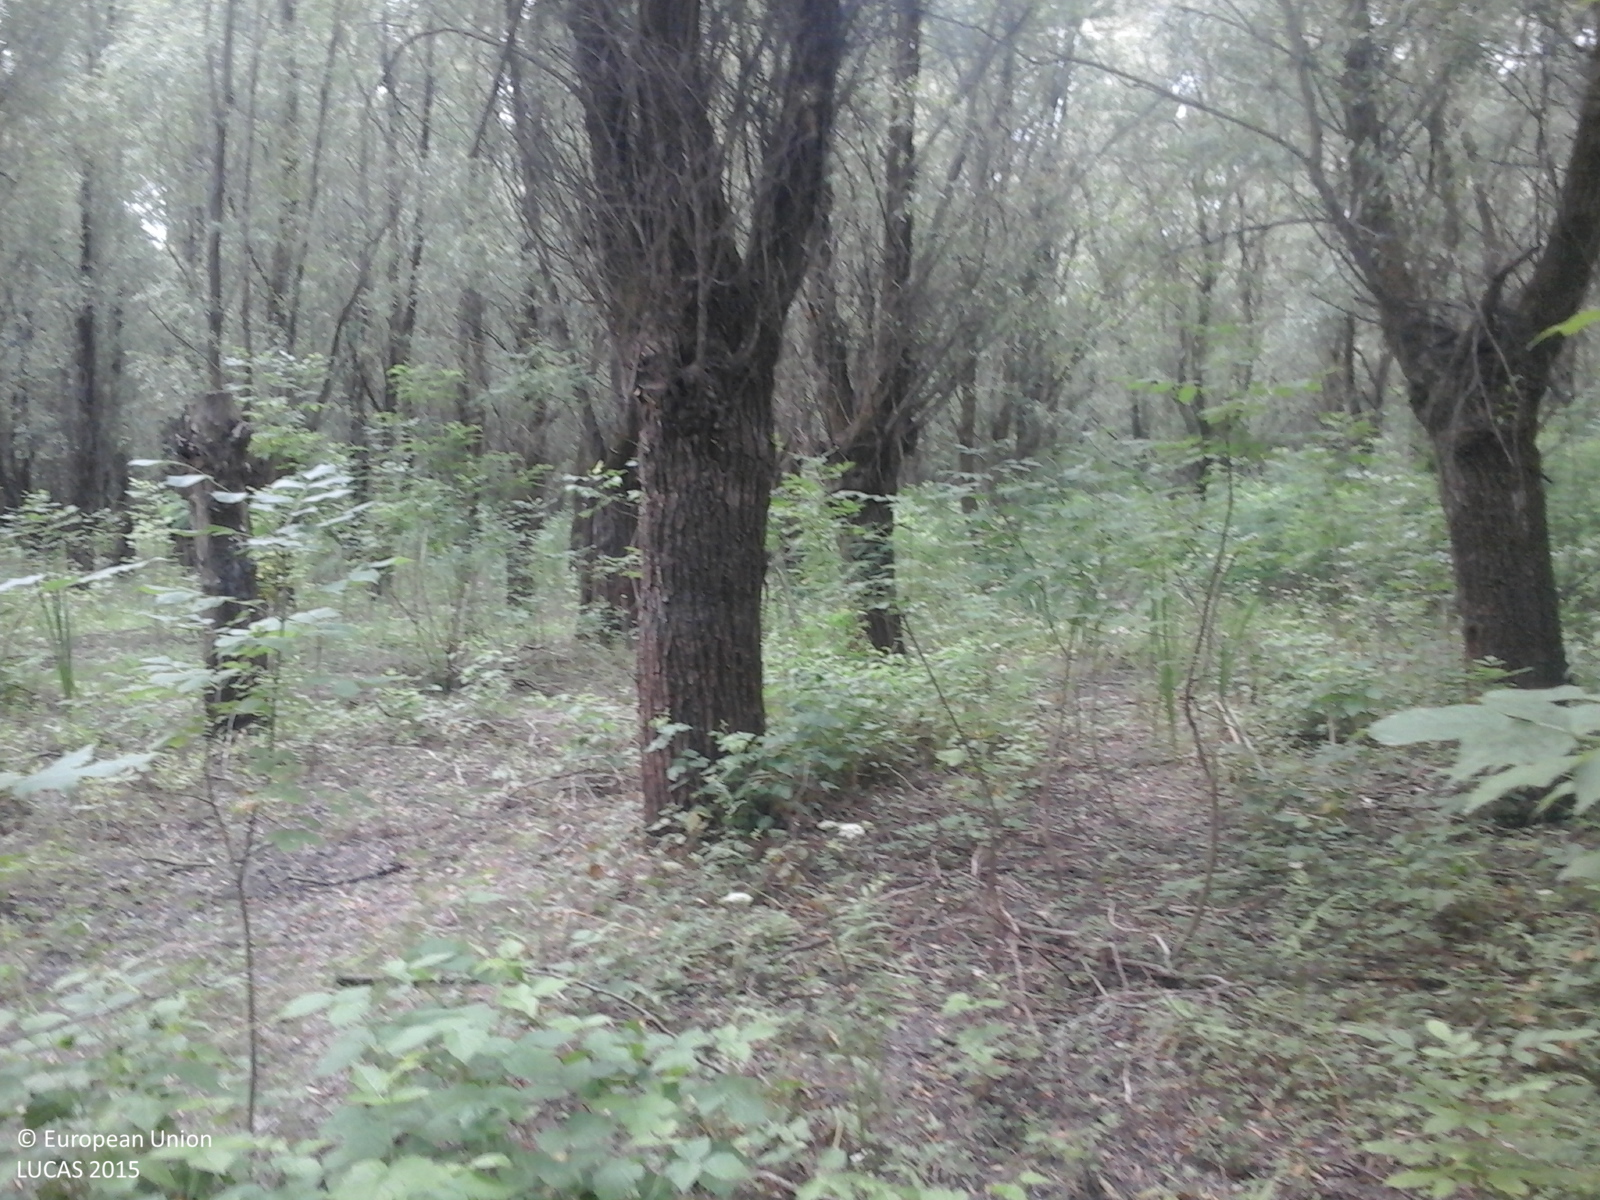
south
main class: Woodland
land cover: Broadleaved woodland
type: floodplain forest
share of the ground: > 75 %
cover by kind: broadleaved forest trees 100 %
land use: Forestry
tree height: > 5 m
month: July
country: RO
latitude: 45.0776
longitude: 28.1437
